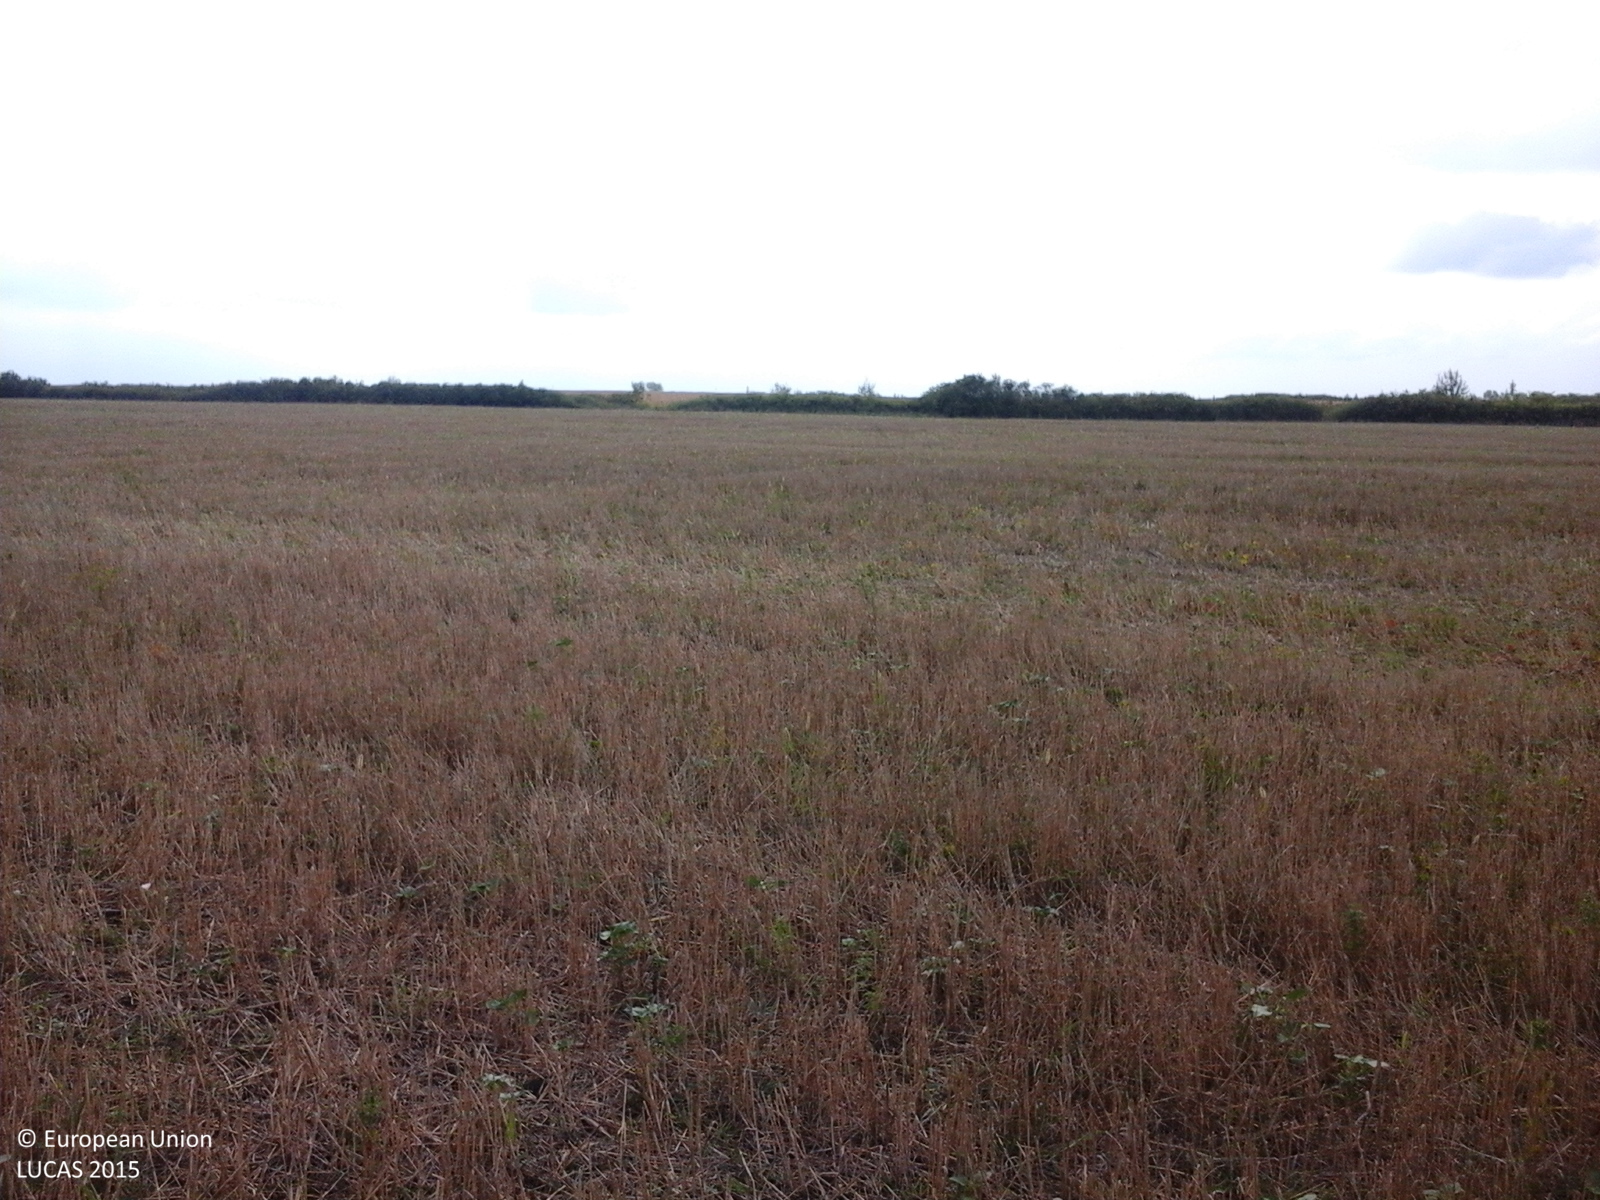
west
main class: Cropland
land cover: Common wheat
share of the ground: 50 - 75 %
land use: Agriculture (excluding fallow land and kitchen gardens)
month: August
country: RO
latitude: 45.7977
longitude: 21.3670
